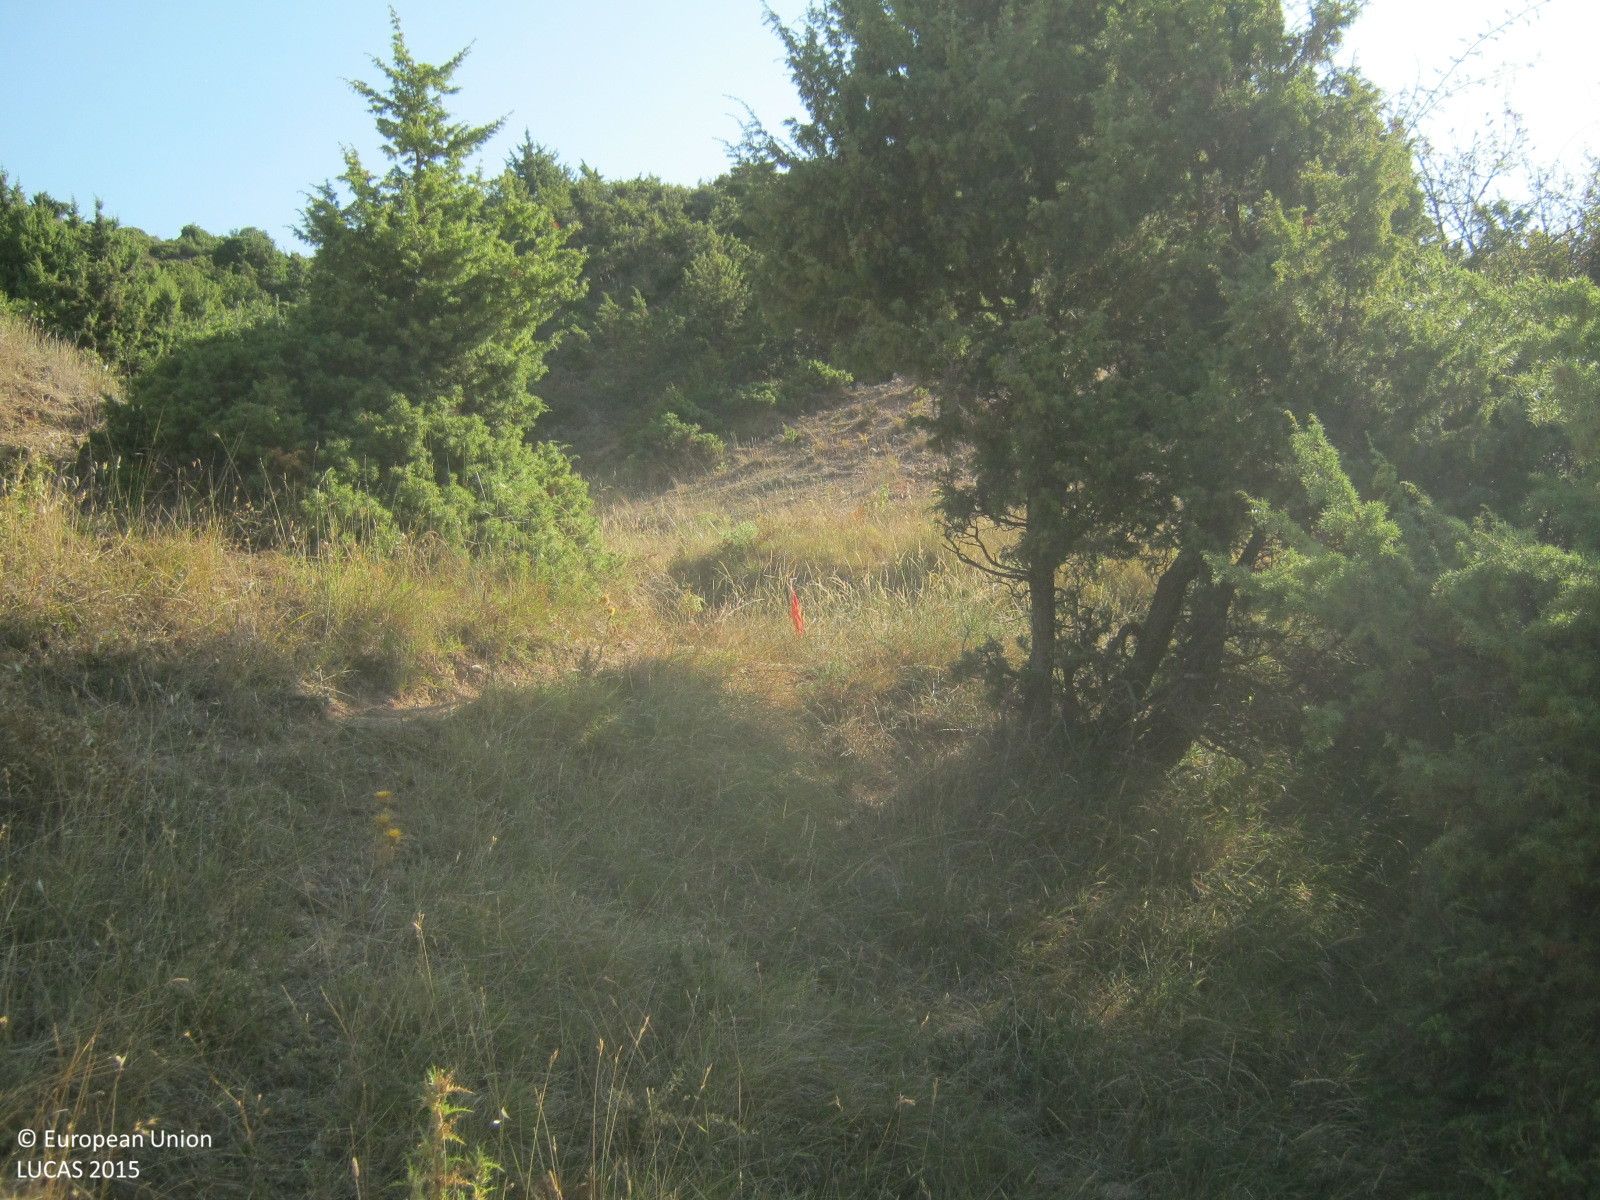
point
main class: Shrubland
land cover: Shrubland without tree cover
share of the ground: 25 - 50 %
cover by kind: herbaceous plants 65 %, shrubs 30 %, unconsolidated bare surface 5 %
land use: Semi-natural and natural areas not in use
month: September
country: GR
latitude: 38.0697
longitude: 22.1073
